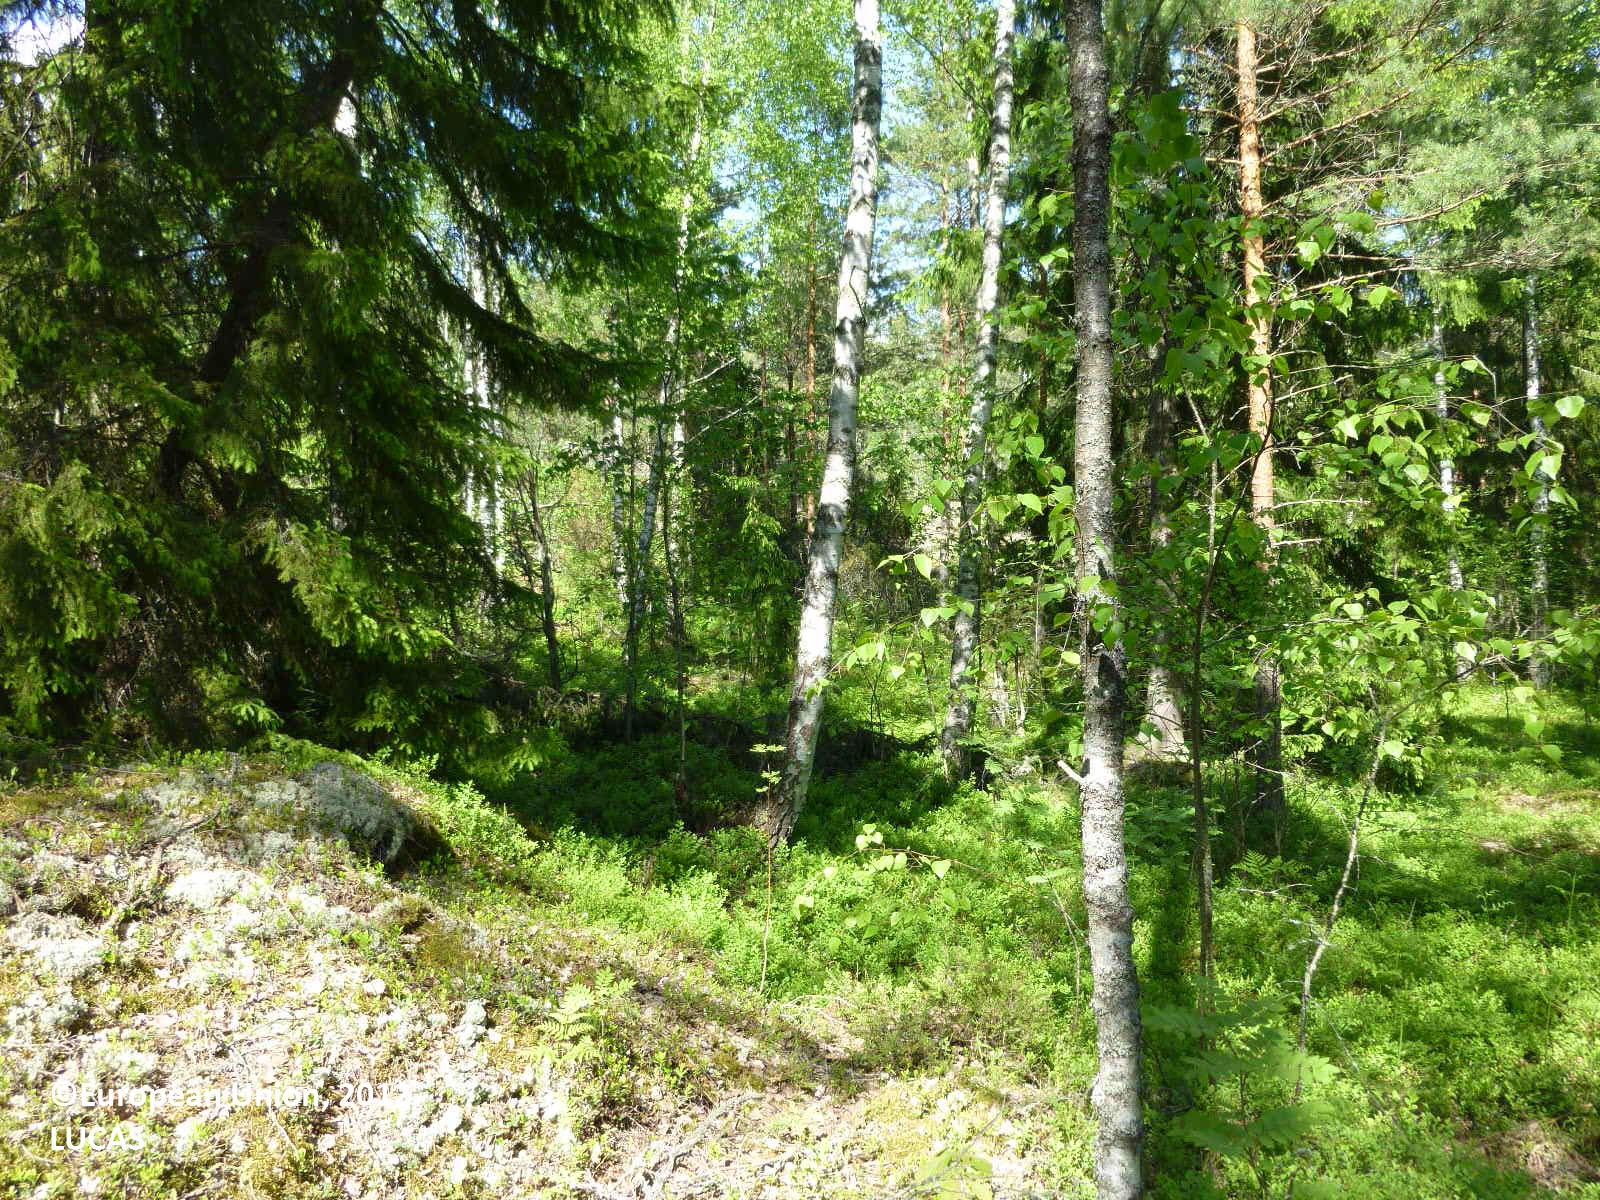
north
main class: Woodland
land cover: Pine dominated coniferous woodland
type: boreal forest
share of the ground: 50 - 75 %
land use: Forestry
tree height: > 5 m
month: June
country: FI
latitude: 60.4148
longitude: 22.6197
